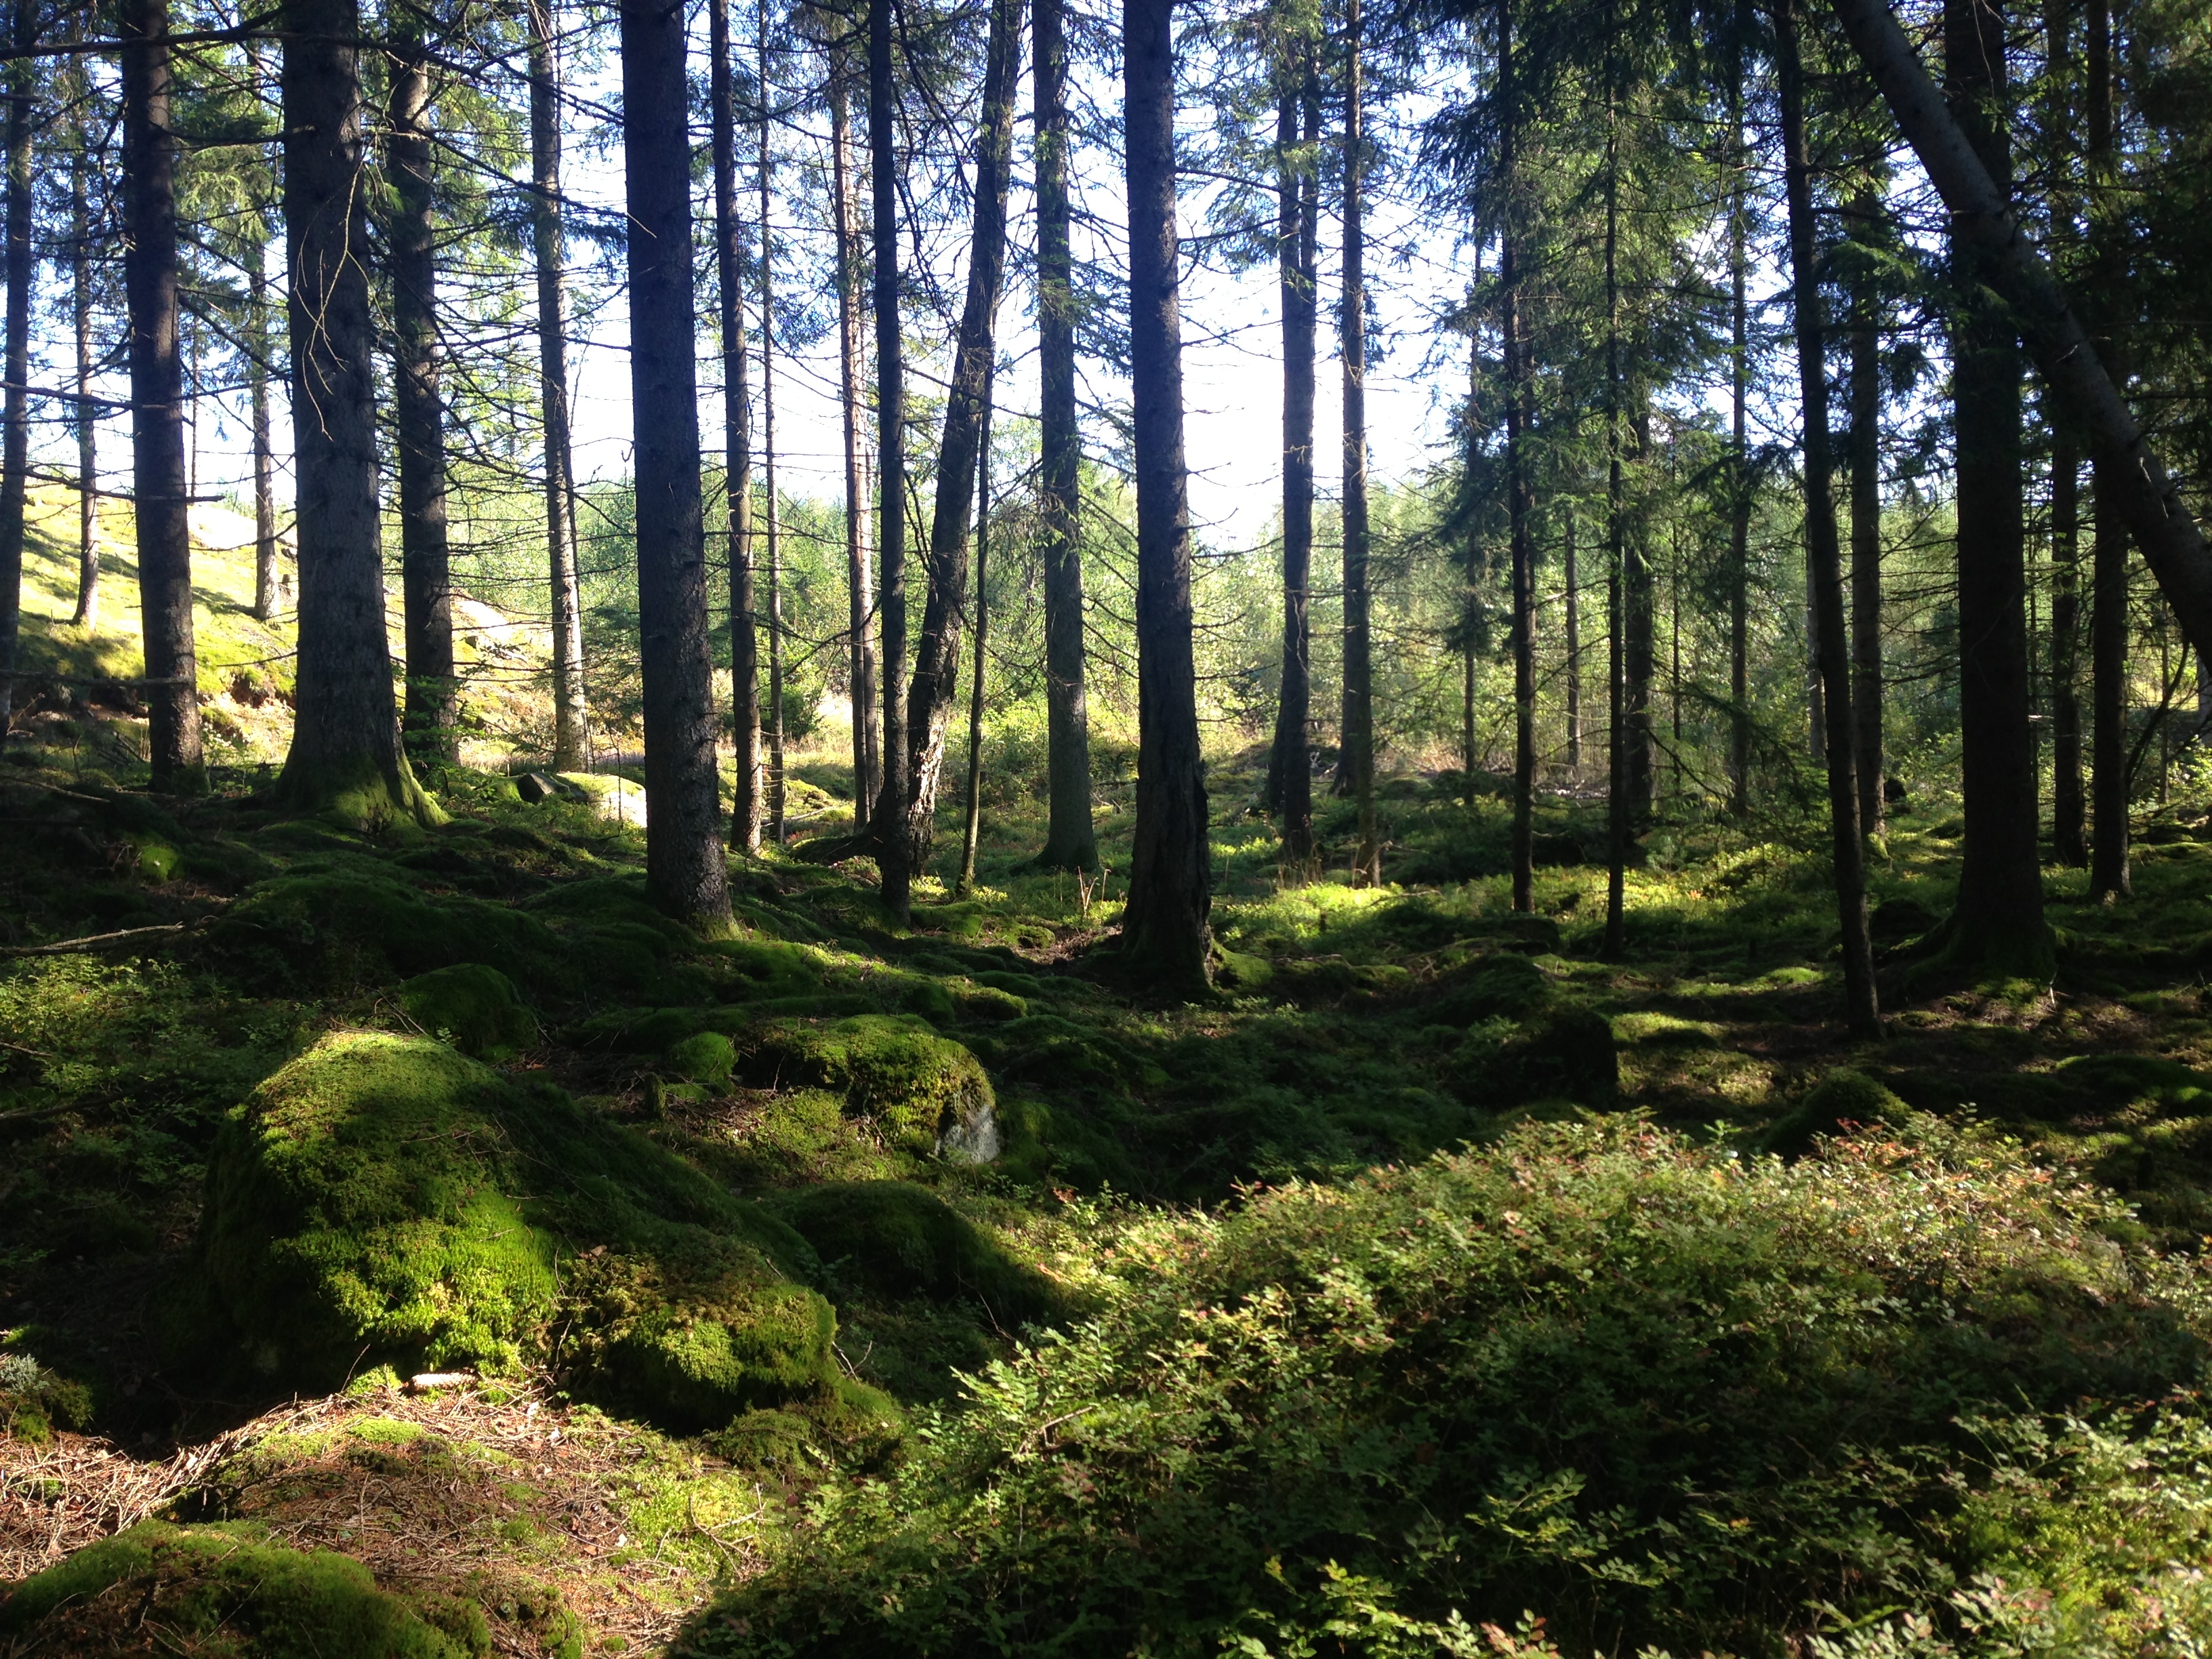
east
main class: Woodland
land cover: Spruce dominated coniferous woodland
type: boreal forest
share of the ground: > 75 %
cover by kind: coniferous forest trees 80 %, shrubs 20 %
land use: Forestry
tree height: > 5 m
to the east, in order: Spruce dominated coniferous woodland; Tracks; Spruce dominated mixed woodland; Other coniferous woodland; Tracks; Other mixed woodland; Other coniferous woodland; Spruce dominated mixed woodland
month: September
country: SE
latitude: 57.1910
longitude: 13.2229
